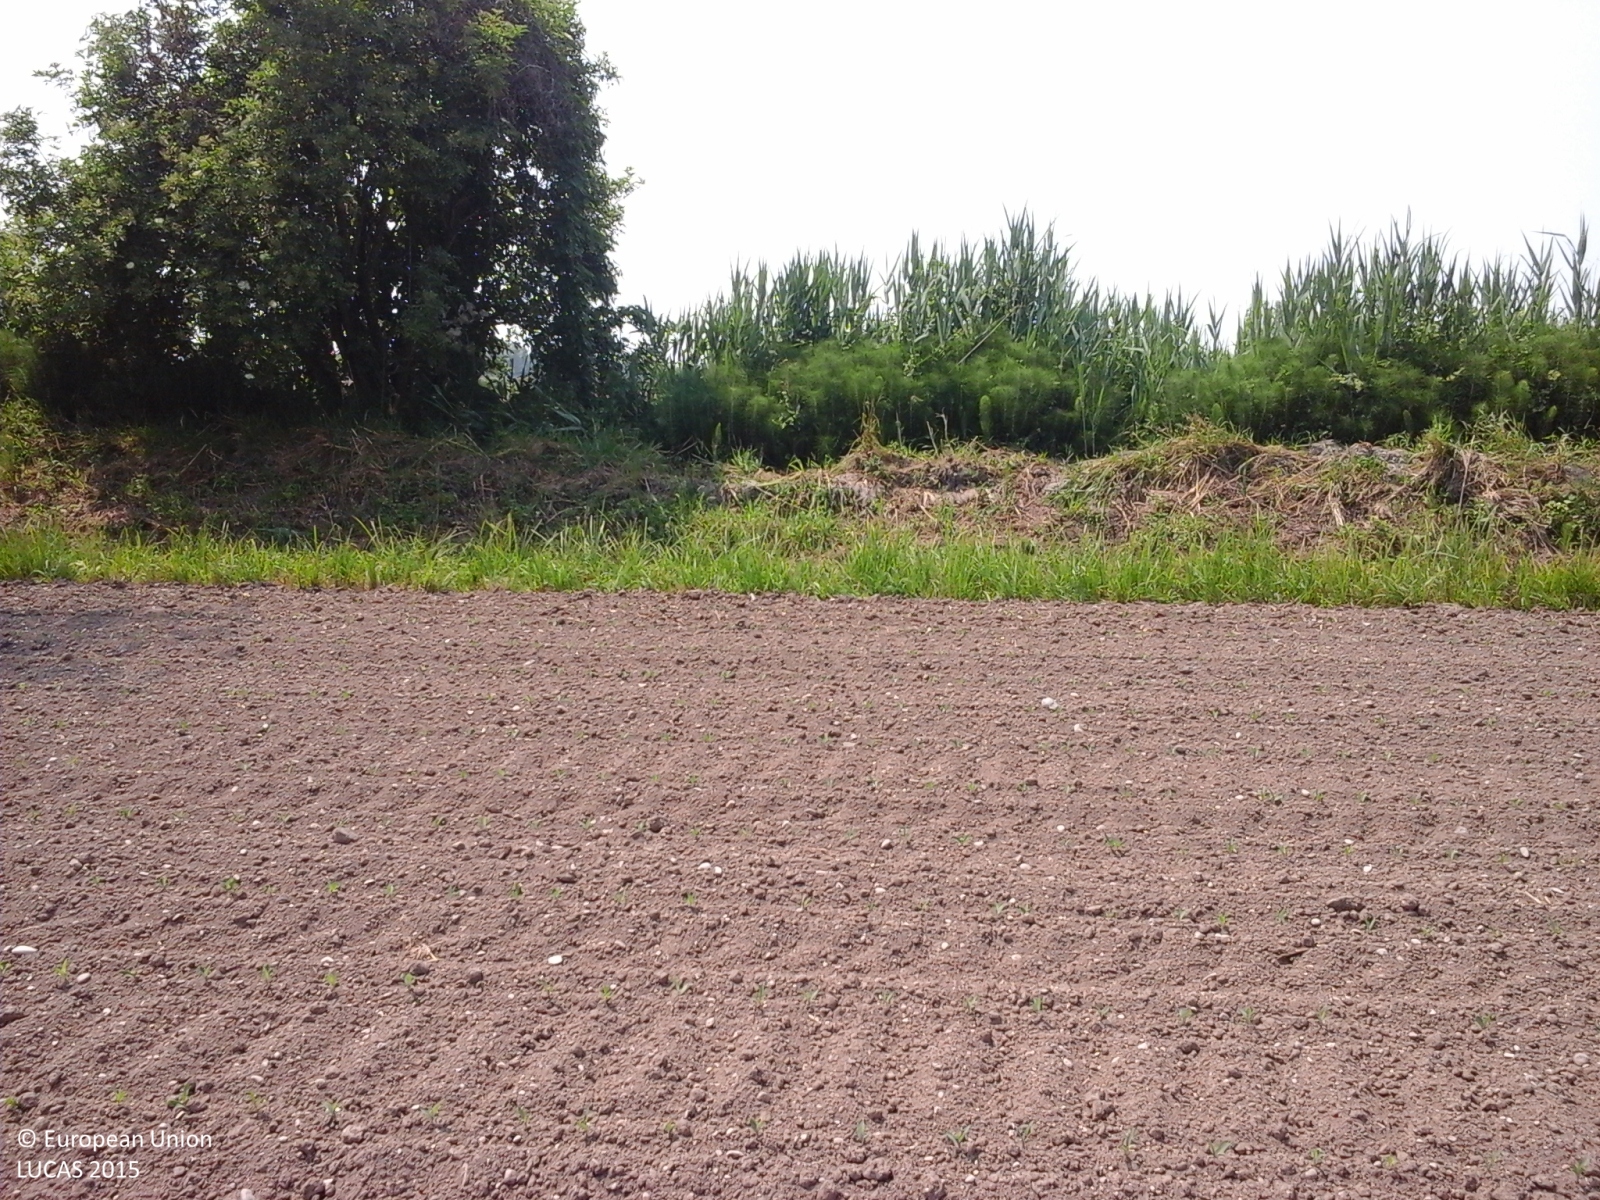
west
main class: Cropland
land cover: Maize
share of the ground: < 10 %
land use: Agriculture (excluding fallow land and kitchen gardens)
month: June
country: IT
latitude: 45.3781
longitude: 10.1912
